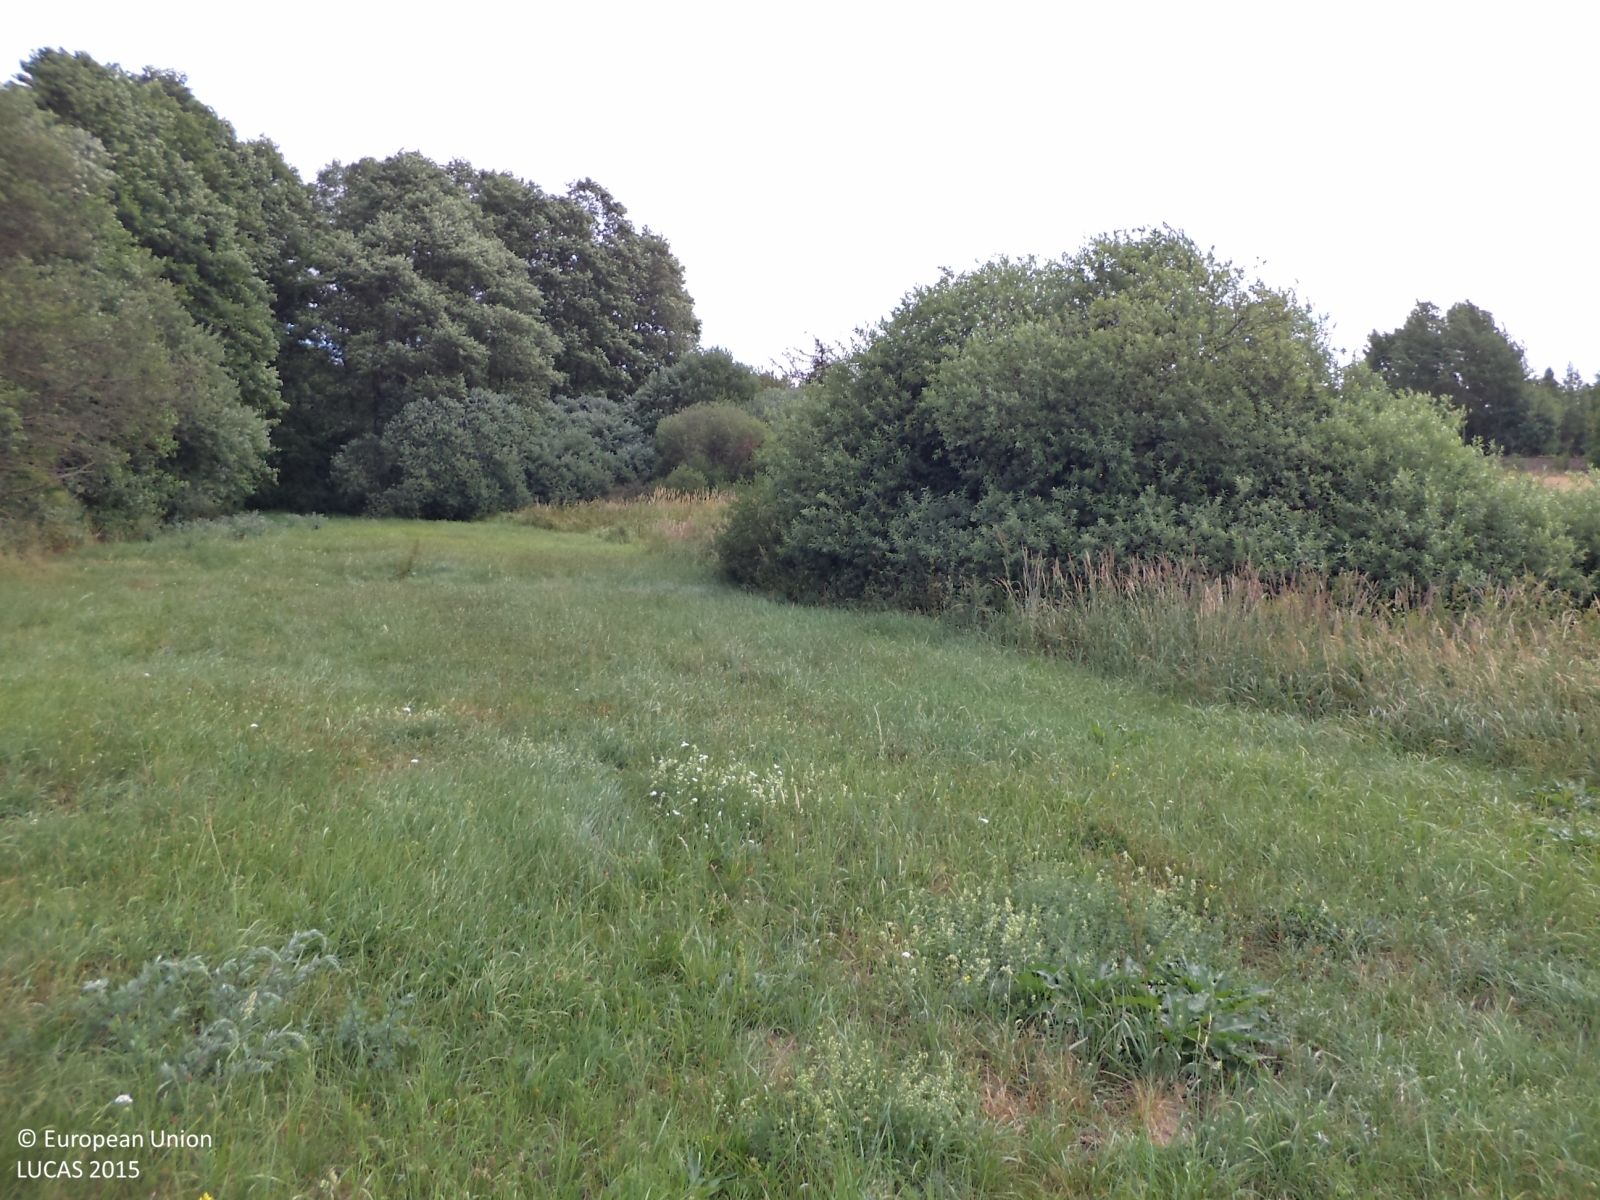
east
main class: Grassland
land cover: Grassland without tree/shrub cover
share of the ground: > 75 %
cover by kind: herbaceous plants 100 %
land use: Agriculture (excluding fallow land and kitchen gardens)
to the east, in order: Grassland without tree/shrub cover; Shrubland with sparse tree cover; Grassland without tree/shrub cover; Rape and turnip rape; Tracks; Spontaneously vegetated surfaces; Broadleaved woodland; Shruby margins; Railways; Shruby margins; Ditches and canals; Shruby margins; Grassland without tree/shrub cover
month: July
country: CZ
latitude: 49.4881
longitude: 13.8796
